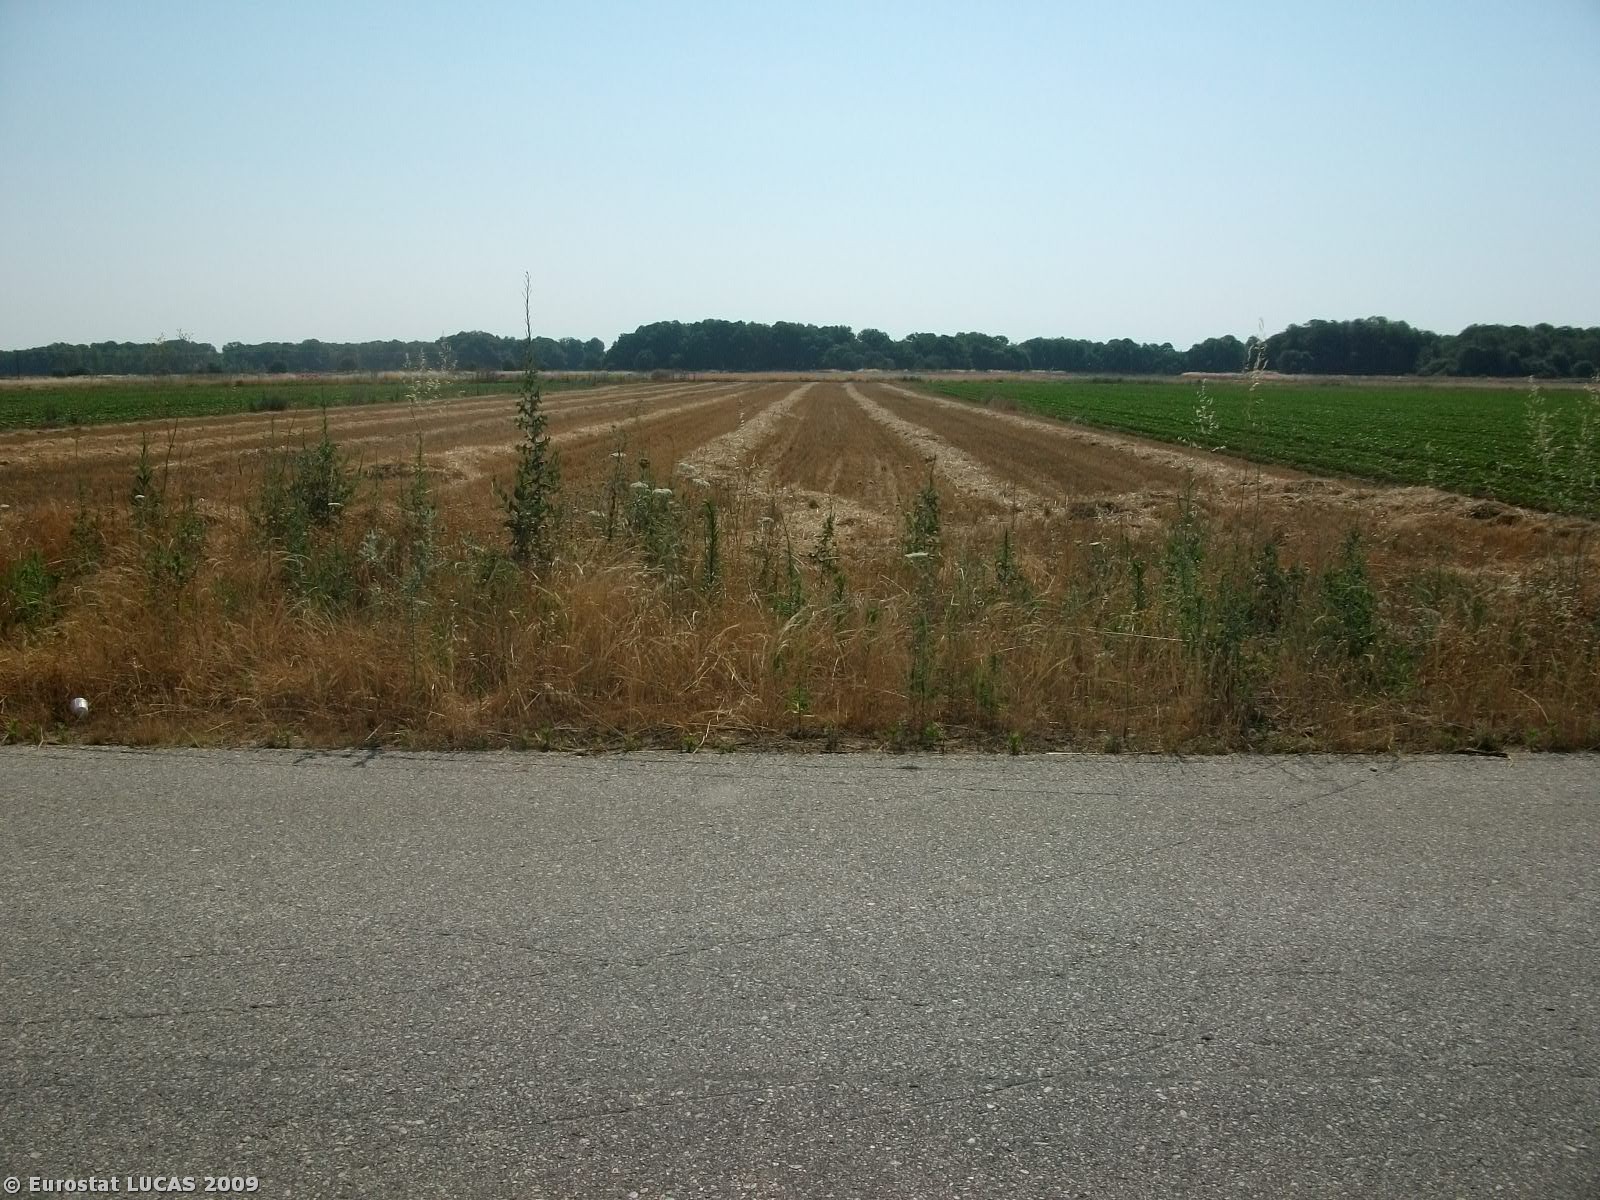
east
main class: Grassland
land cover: Spontaneously vegetated surfaces
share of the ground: > 75 %
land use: Unused
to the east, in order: Spontaneously vegetated surfaces; Ditches and canals; Grass margins; Paved roads, cycling and walking lanes; Grass margins; Durum wheat
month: June
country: GR
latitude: 39.3161
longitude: 21.9398
